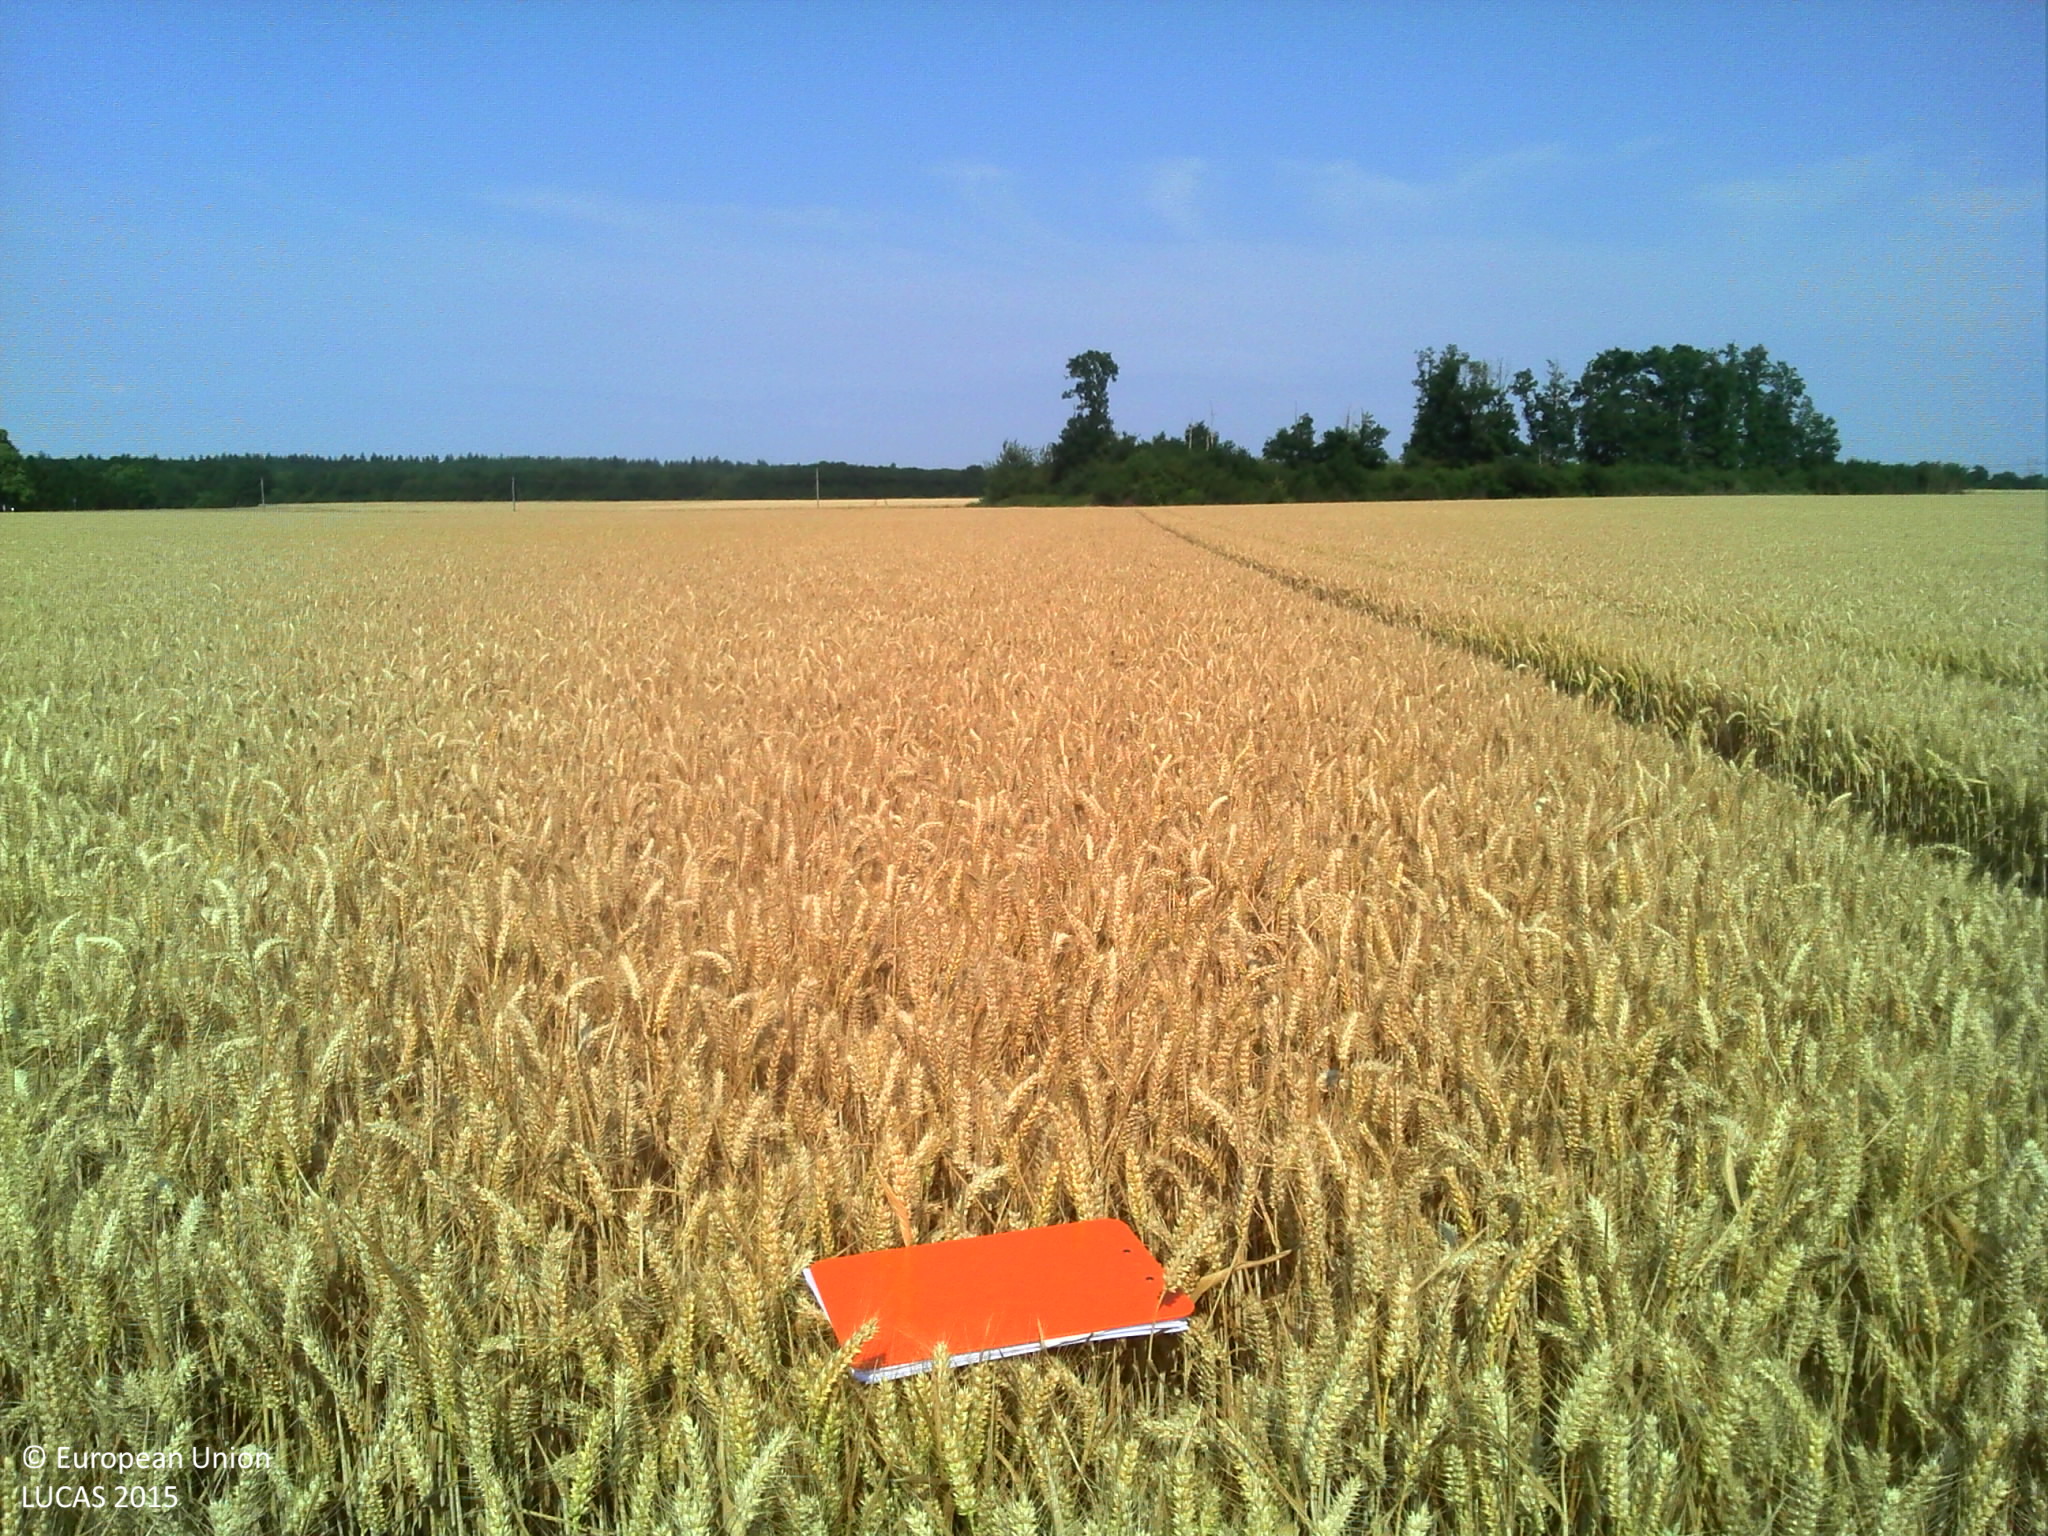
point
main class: Cropland
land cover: Common wheat
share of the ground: > 75 %
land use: Agriculture (excluding fallow land and kitchen gardens)
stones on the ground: < 10 %
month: July
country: FR
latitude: 48.8719
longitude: 1.2687
